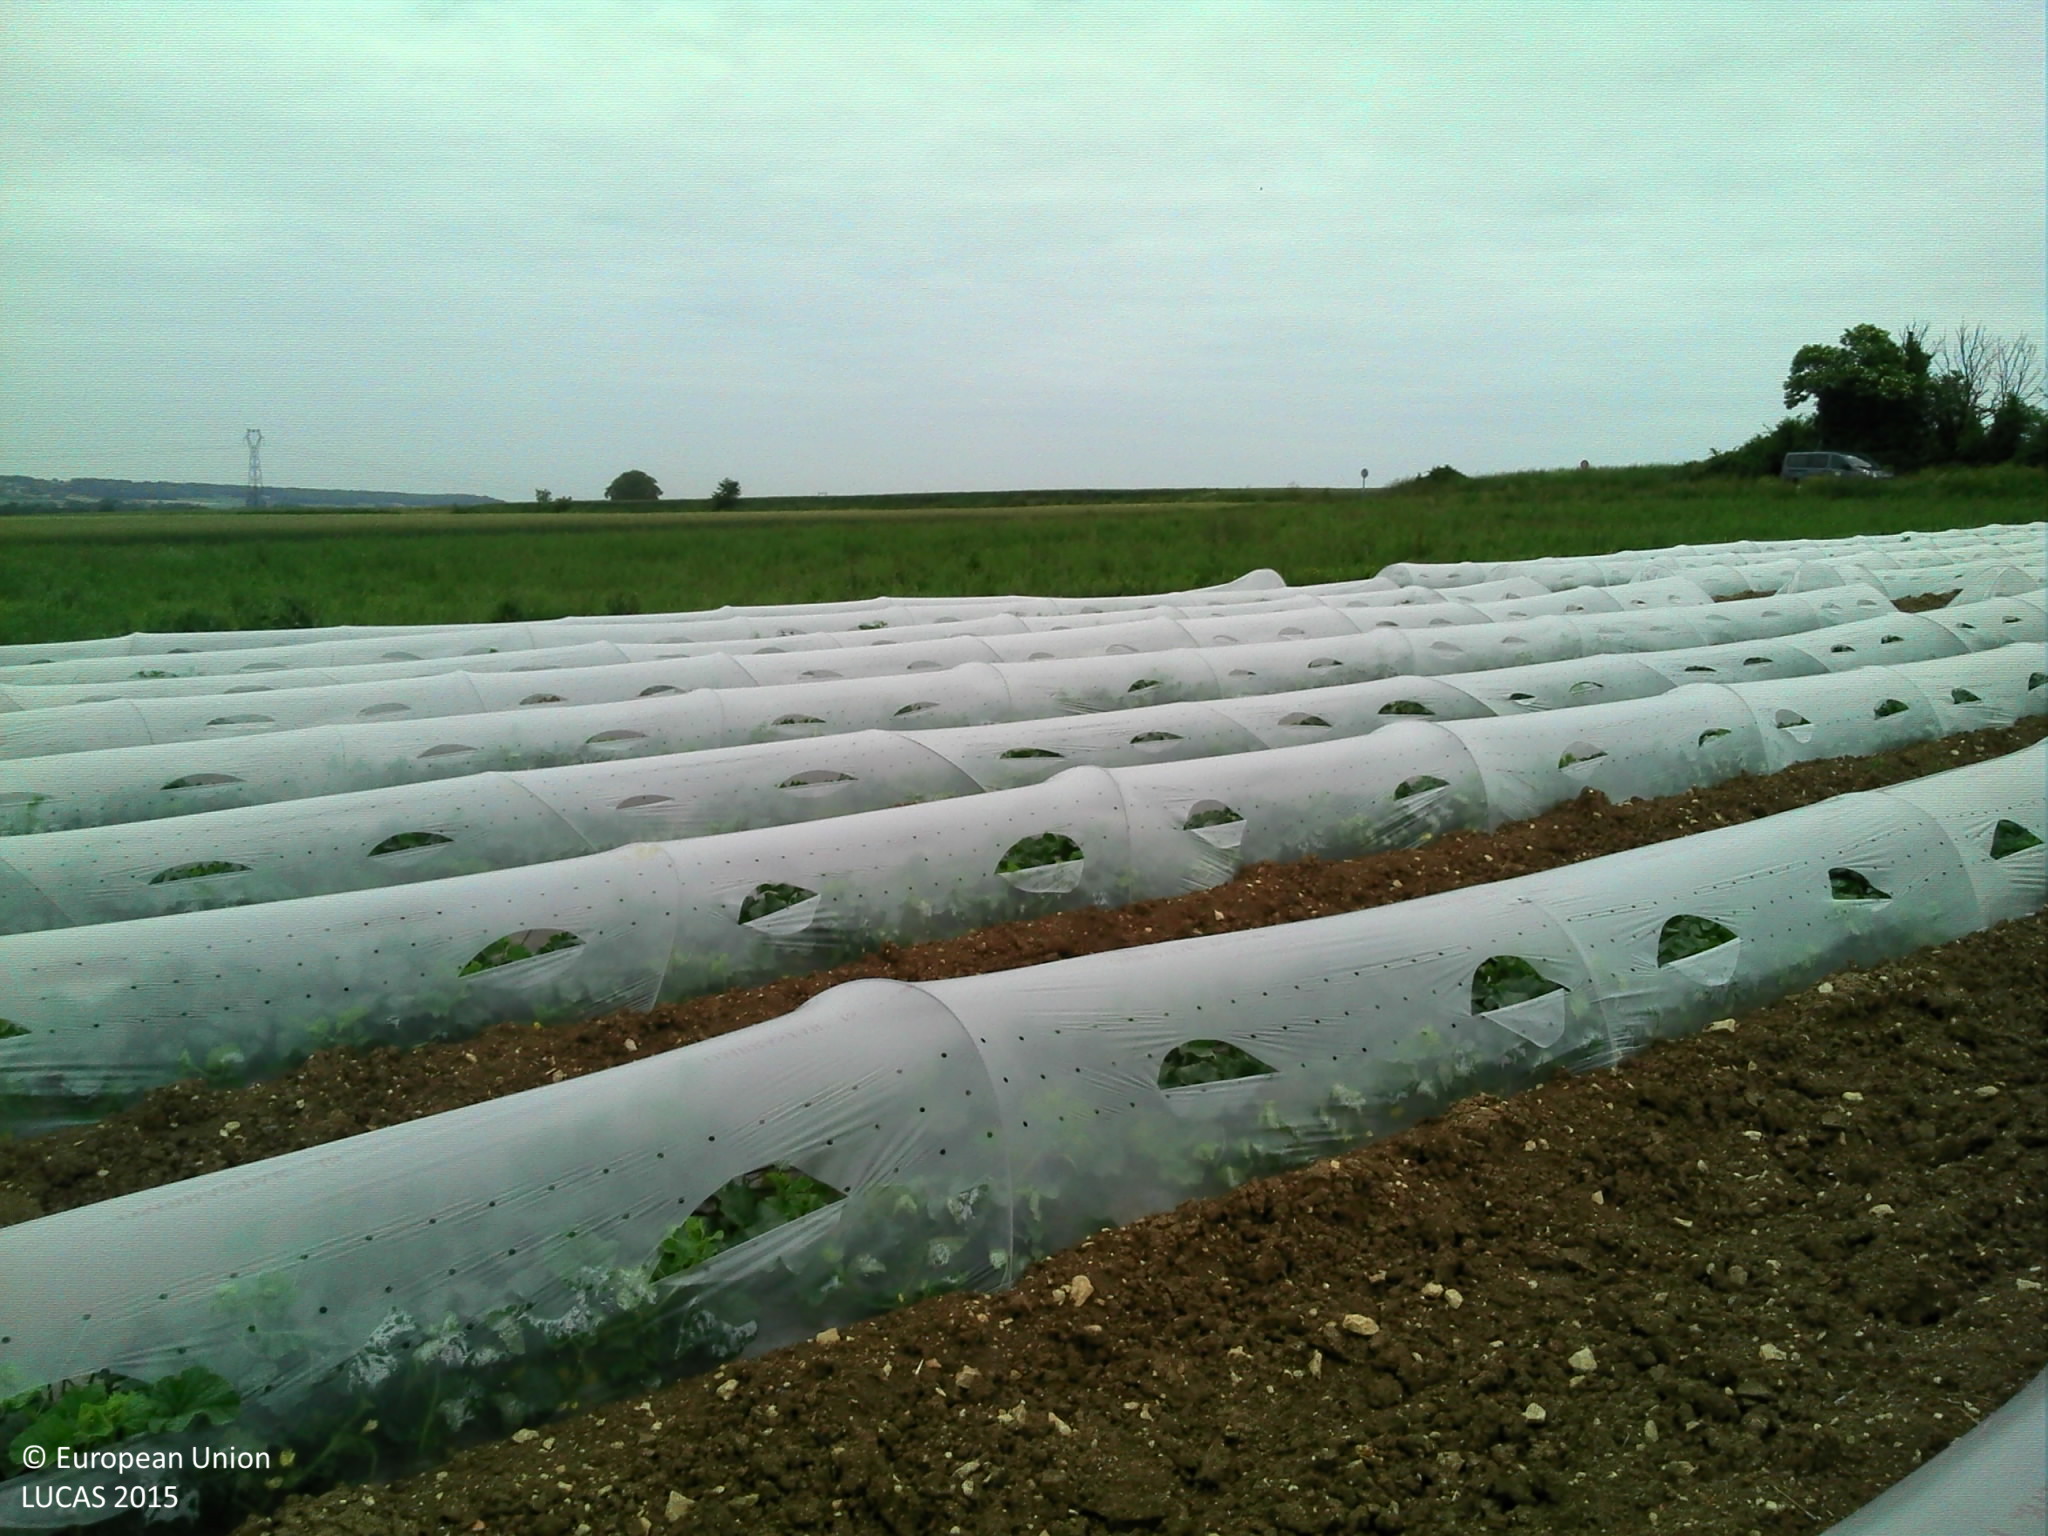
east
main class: Cropland
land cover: Other fresh vegetables
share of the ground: 50 - 75 %
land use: Agriculture (excluding fallow land and kitchen gardens)
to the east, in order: Other fresh vegetables; Lucerne; Grass margins; Tracks; Grass margins; Tracks; Common wheat
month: May
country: FR
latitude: 46.7038
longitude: 0.2619
